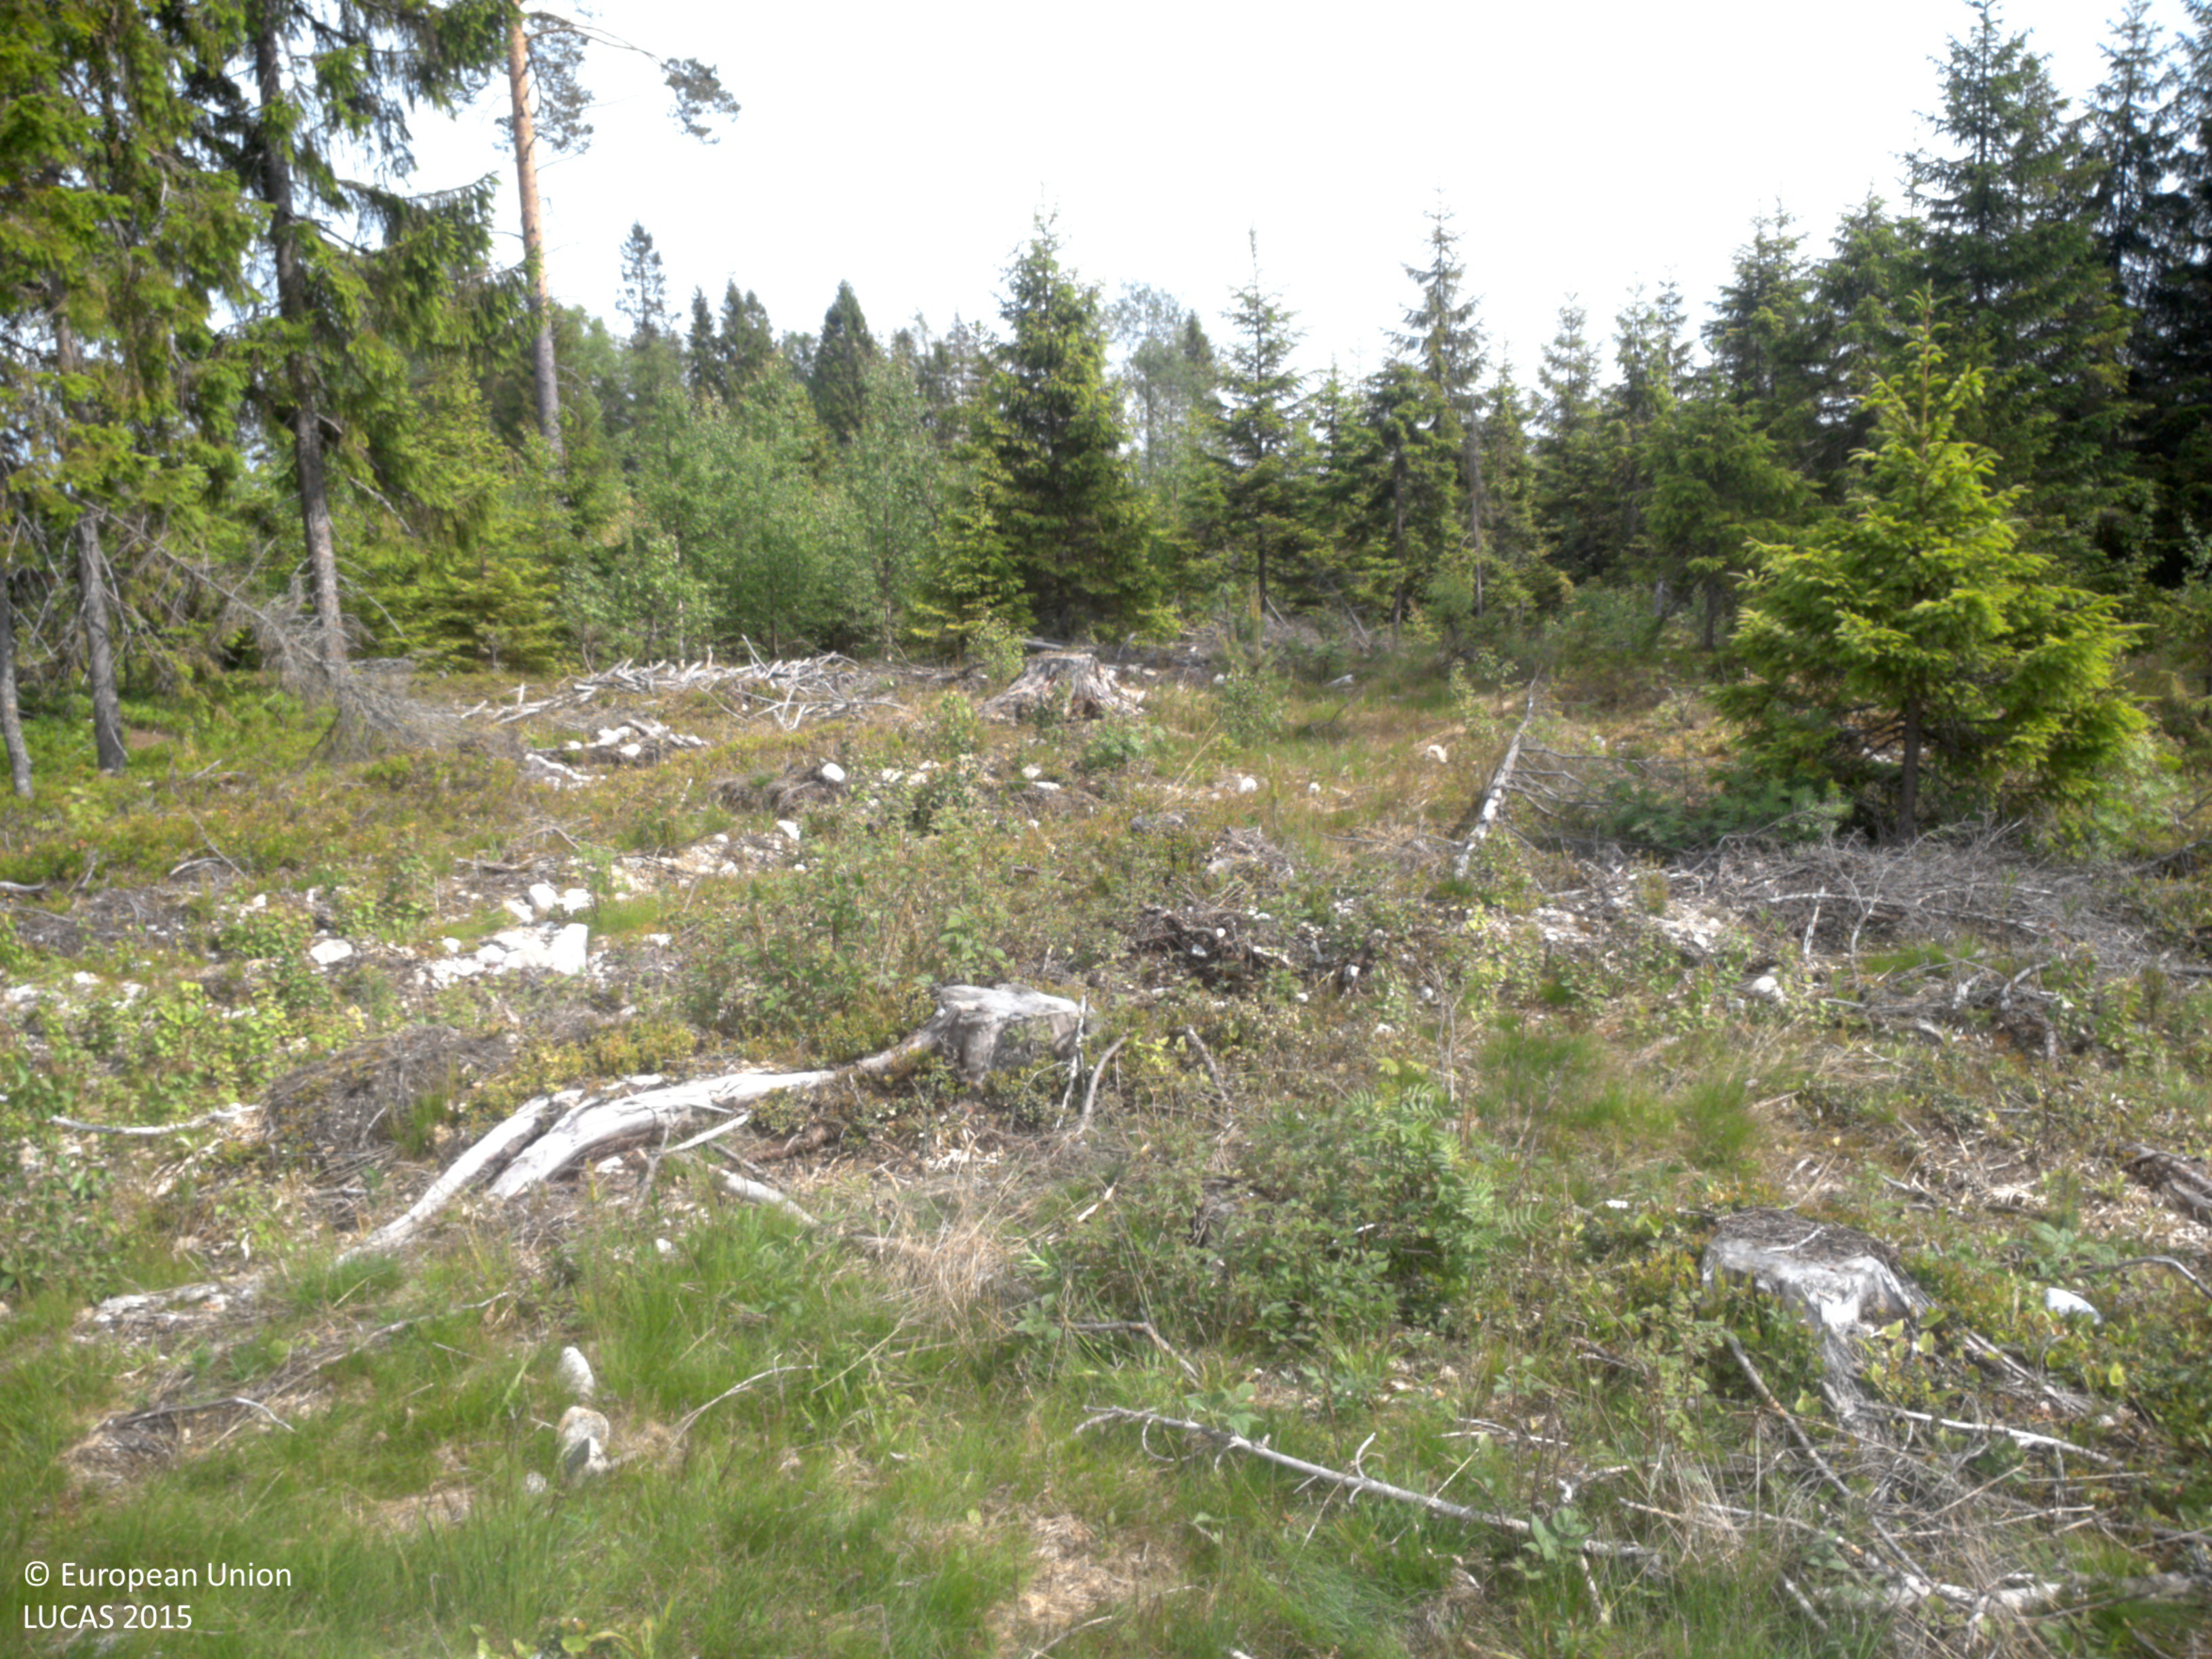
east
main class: Shrubland
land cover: Shrubland with sparse tree cover
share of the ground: 25 - 50 %
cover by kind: herbaceous plants 40 %, shrubs 35 %, unconsolidated bare surface 20 %, coniferous forest trees 5 %
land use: Forestry
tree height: > 5 m
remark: Clear cut
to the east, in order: Shrubland with sparse tree cover; Other mixed woodland; Sand; Paved roads, cycling and walking lanes; Ditches and canals; Spruce dominated mixed woodland
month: June
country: SE
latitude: 63.6587
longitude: 19.7772
